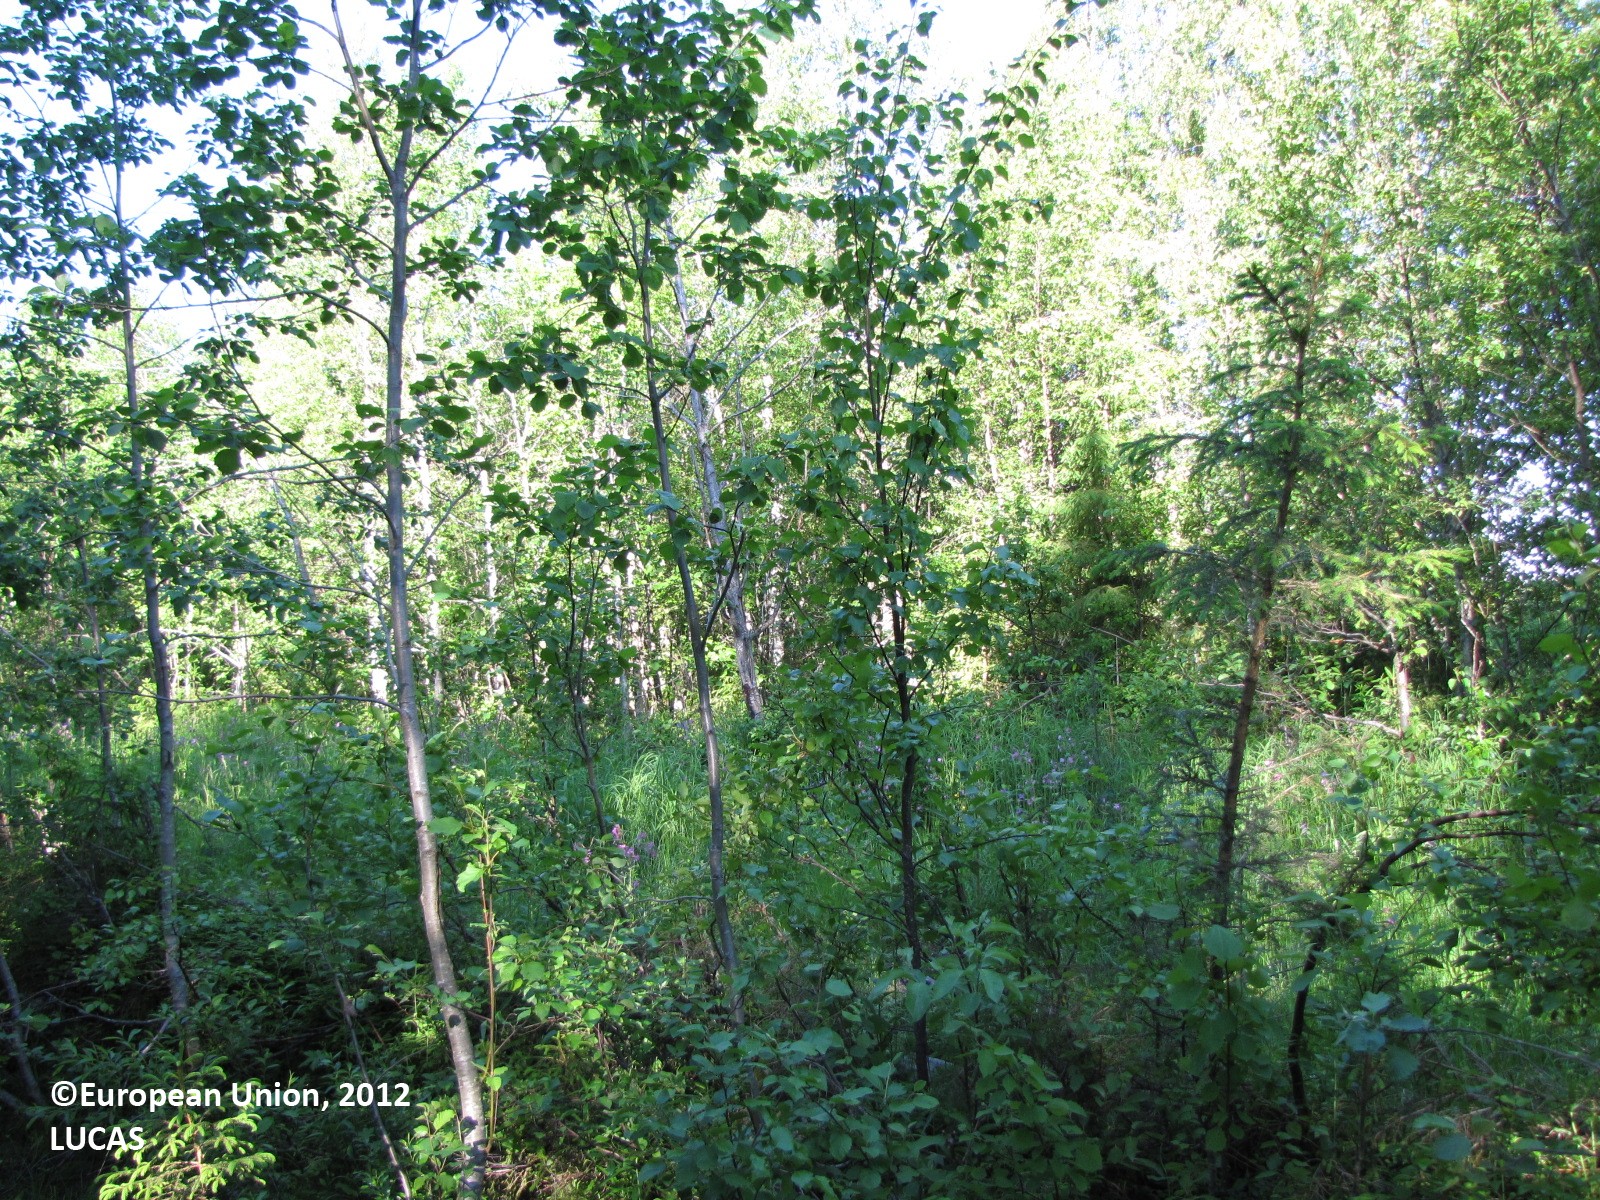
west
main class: Woodland
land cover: Spruce dominated mixed woodland
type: boreal forest
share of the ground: 25 - 50 %
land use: Forestry
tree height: > 5 m
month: July
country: FI
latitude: 66.1020
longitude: 24.1351
